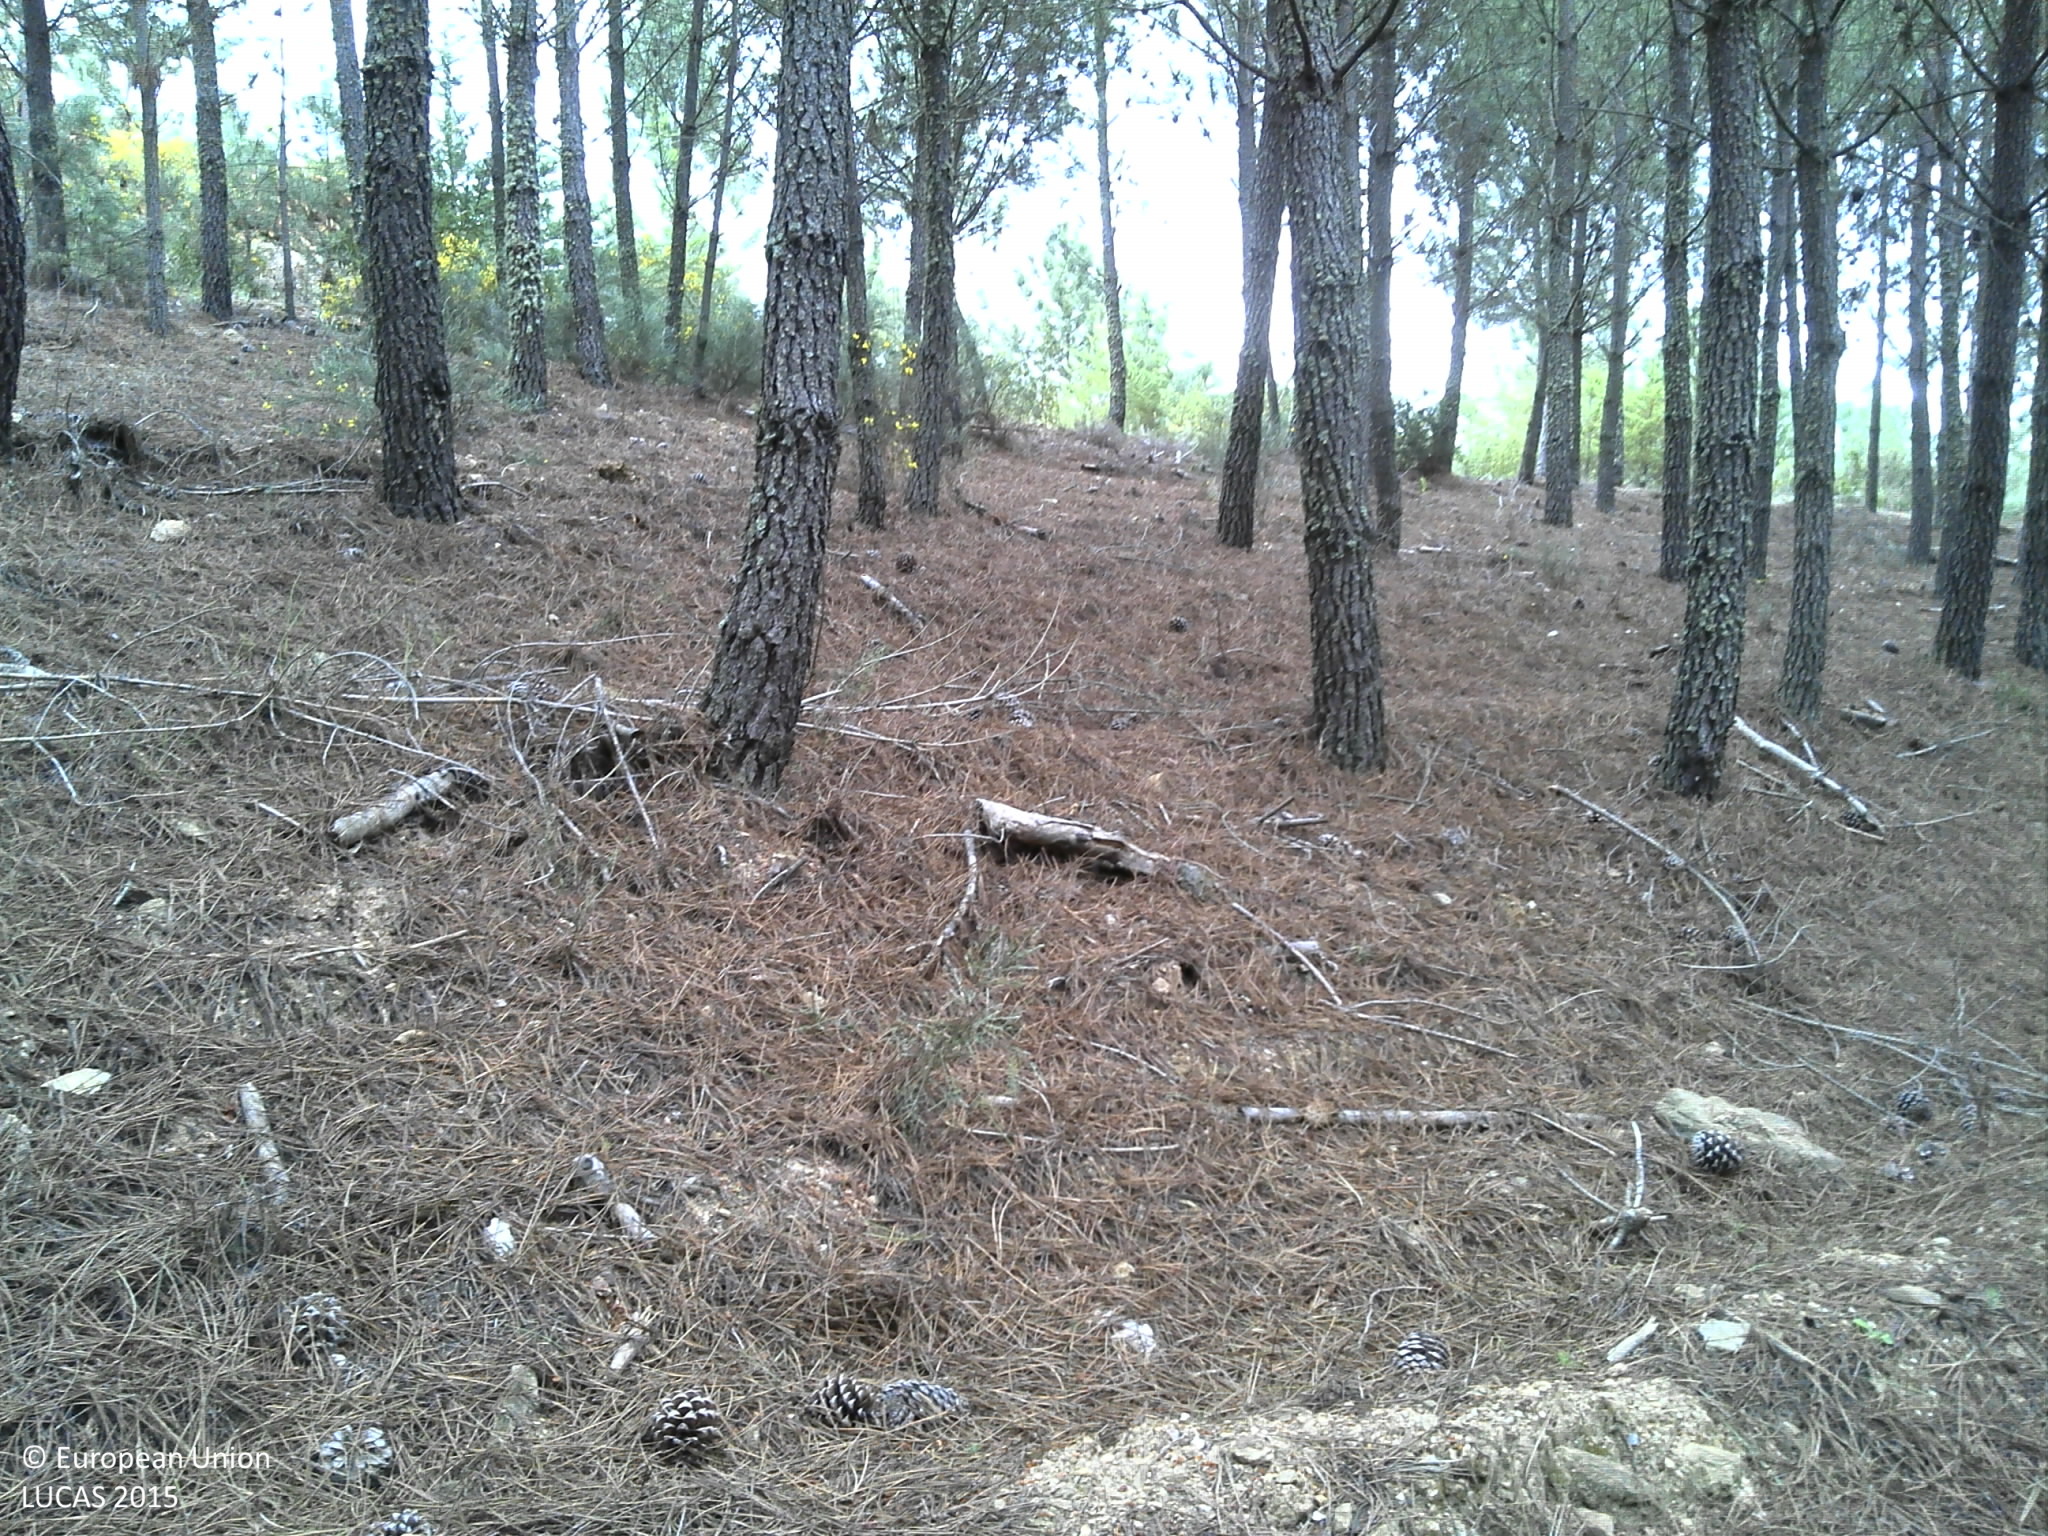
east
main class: Woodland
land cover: Pine dominated coniferous woodland
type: coniferous forest of the mediterranean region
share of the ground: 50 - 75 %
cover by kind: coniferous forest trees 75 %, unconsolidated bare surface 25 %
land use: Forestry
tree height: > 5 m
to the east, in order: Pine dominated coniferous woodland; Tracks; Pine dominated coniferous woodland; Shrubland with sparse tree cover
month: May
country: PT
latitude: 41.7596
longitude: -7.0917
